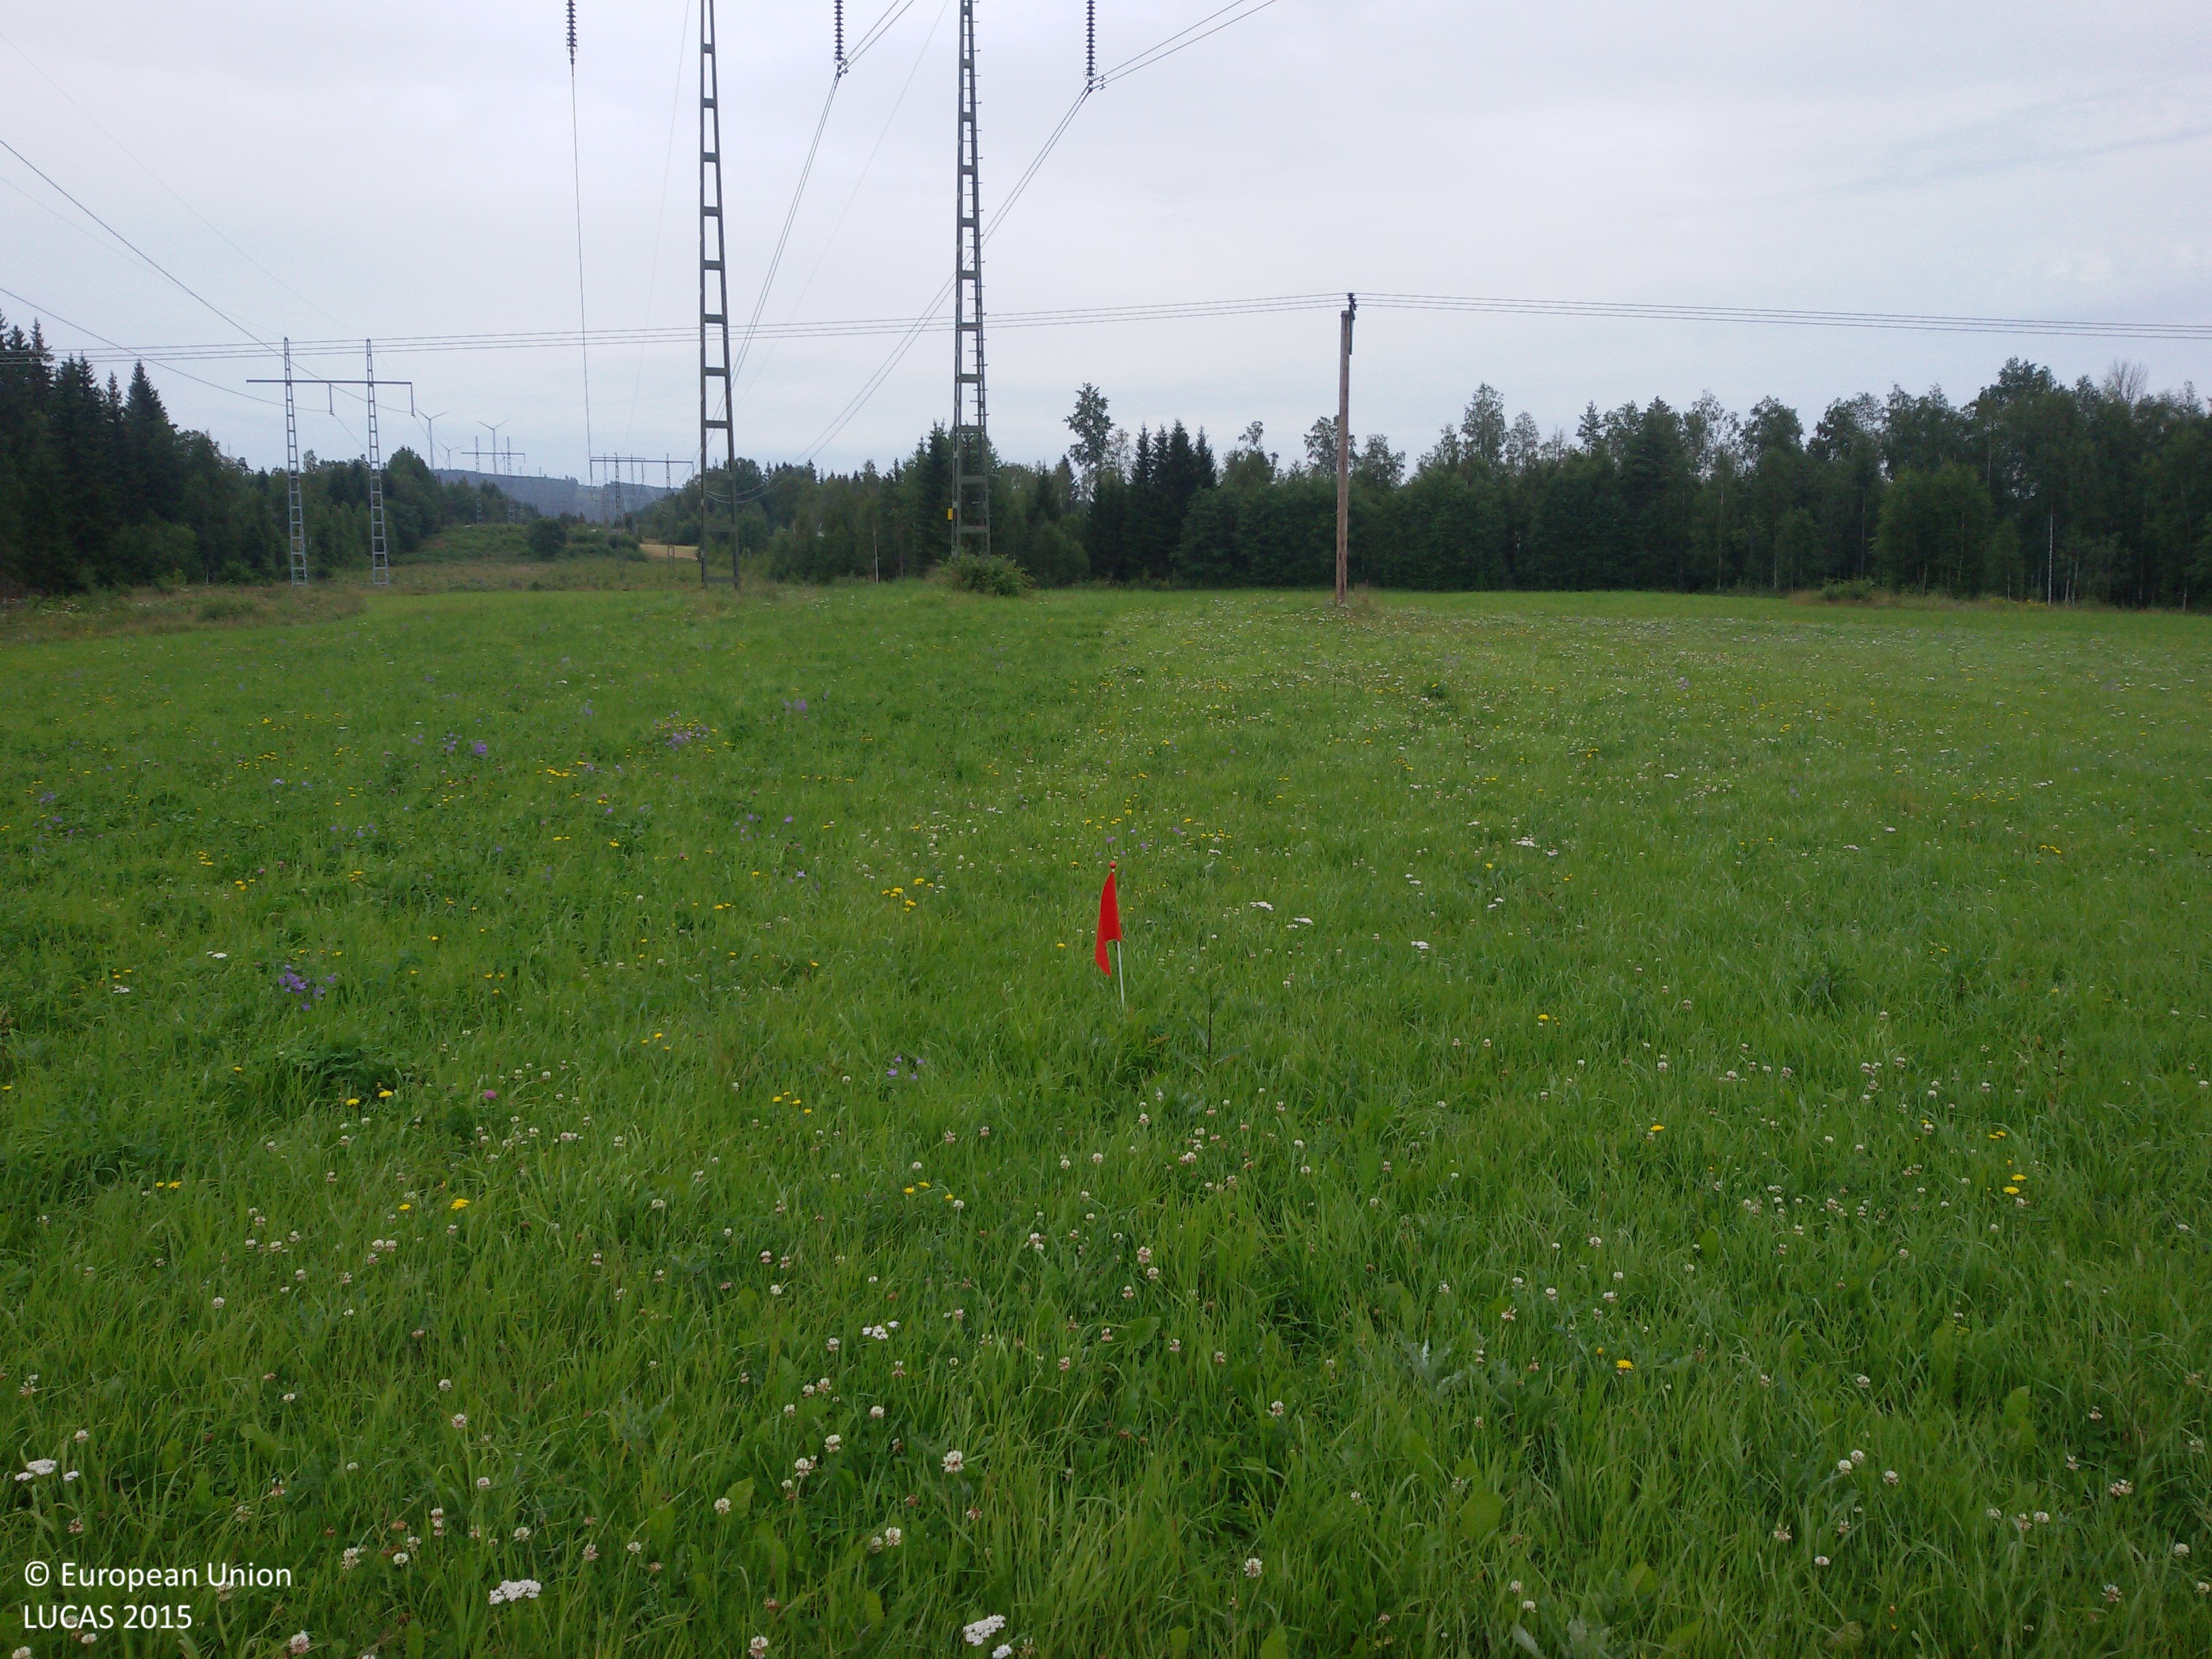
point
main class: Artificial land
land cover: Other artificial areas
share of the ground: > 75 %
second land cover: Grassland without tree/shrub cover
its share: > 75 %
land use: Electricity, gas and thermal power distribution
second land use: Agriculture (excluding fallow land and kitchen gardens)
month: August
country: SE
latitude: 60.7325
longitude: 16.5706
